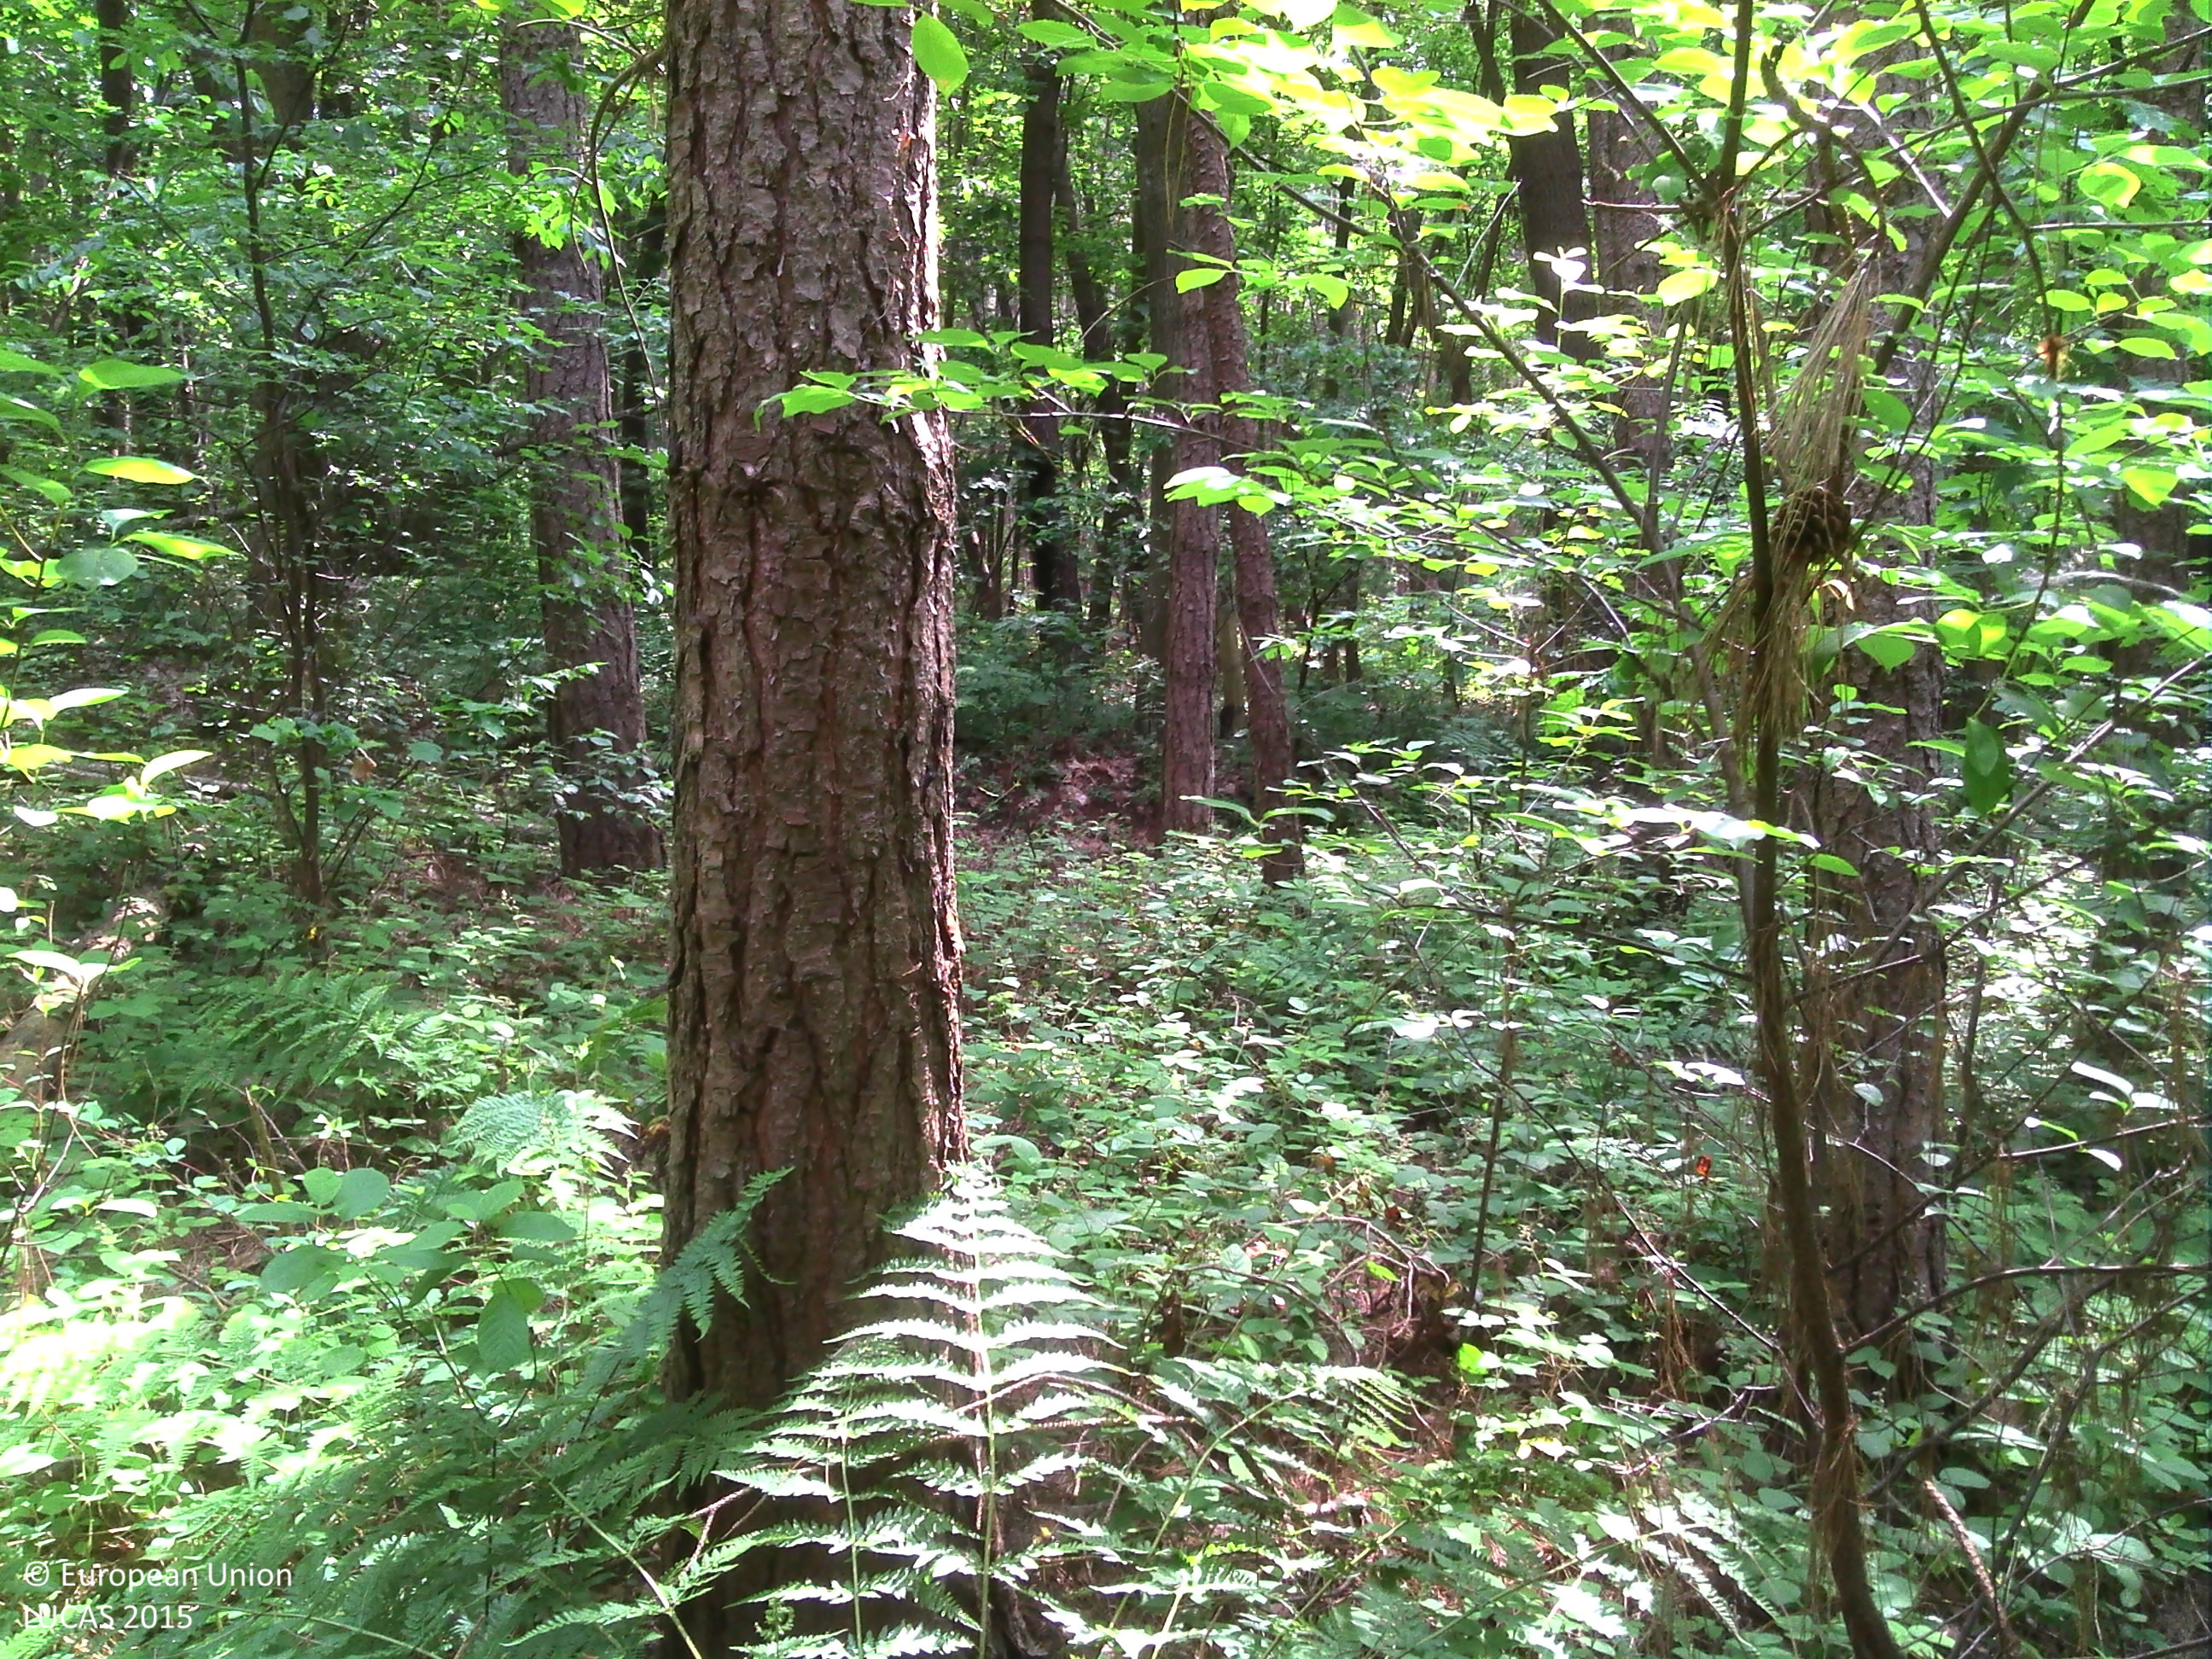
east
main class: Woodland
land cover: Pine dominated mixed woodland
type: exotic forest
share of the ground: > 75 %
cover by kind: coniferous forest trees 75 %, broadleaved forest trees 25 %
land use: Forestry
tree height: > 5 m
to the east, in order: Pine dominated mixed woodland; Tracks; Broadleaved woodland; Pine dominated coniferous woodland; Pine dominated mixed woodland; Tracks; Pine dominated mixed woodland
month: June
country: BE
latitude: 51.0303
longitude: 5.0207
